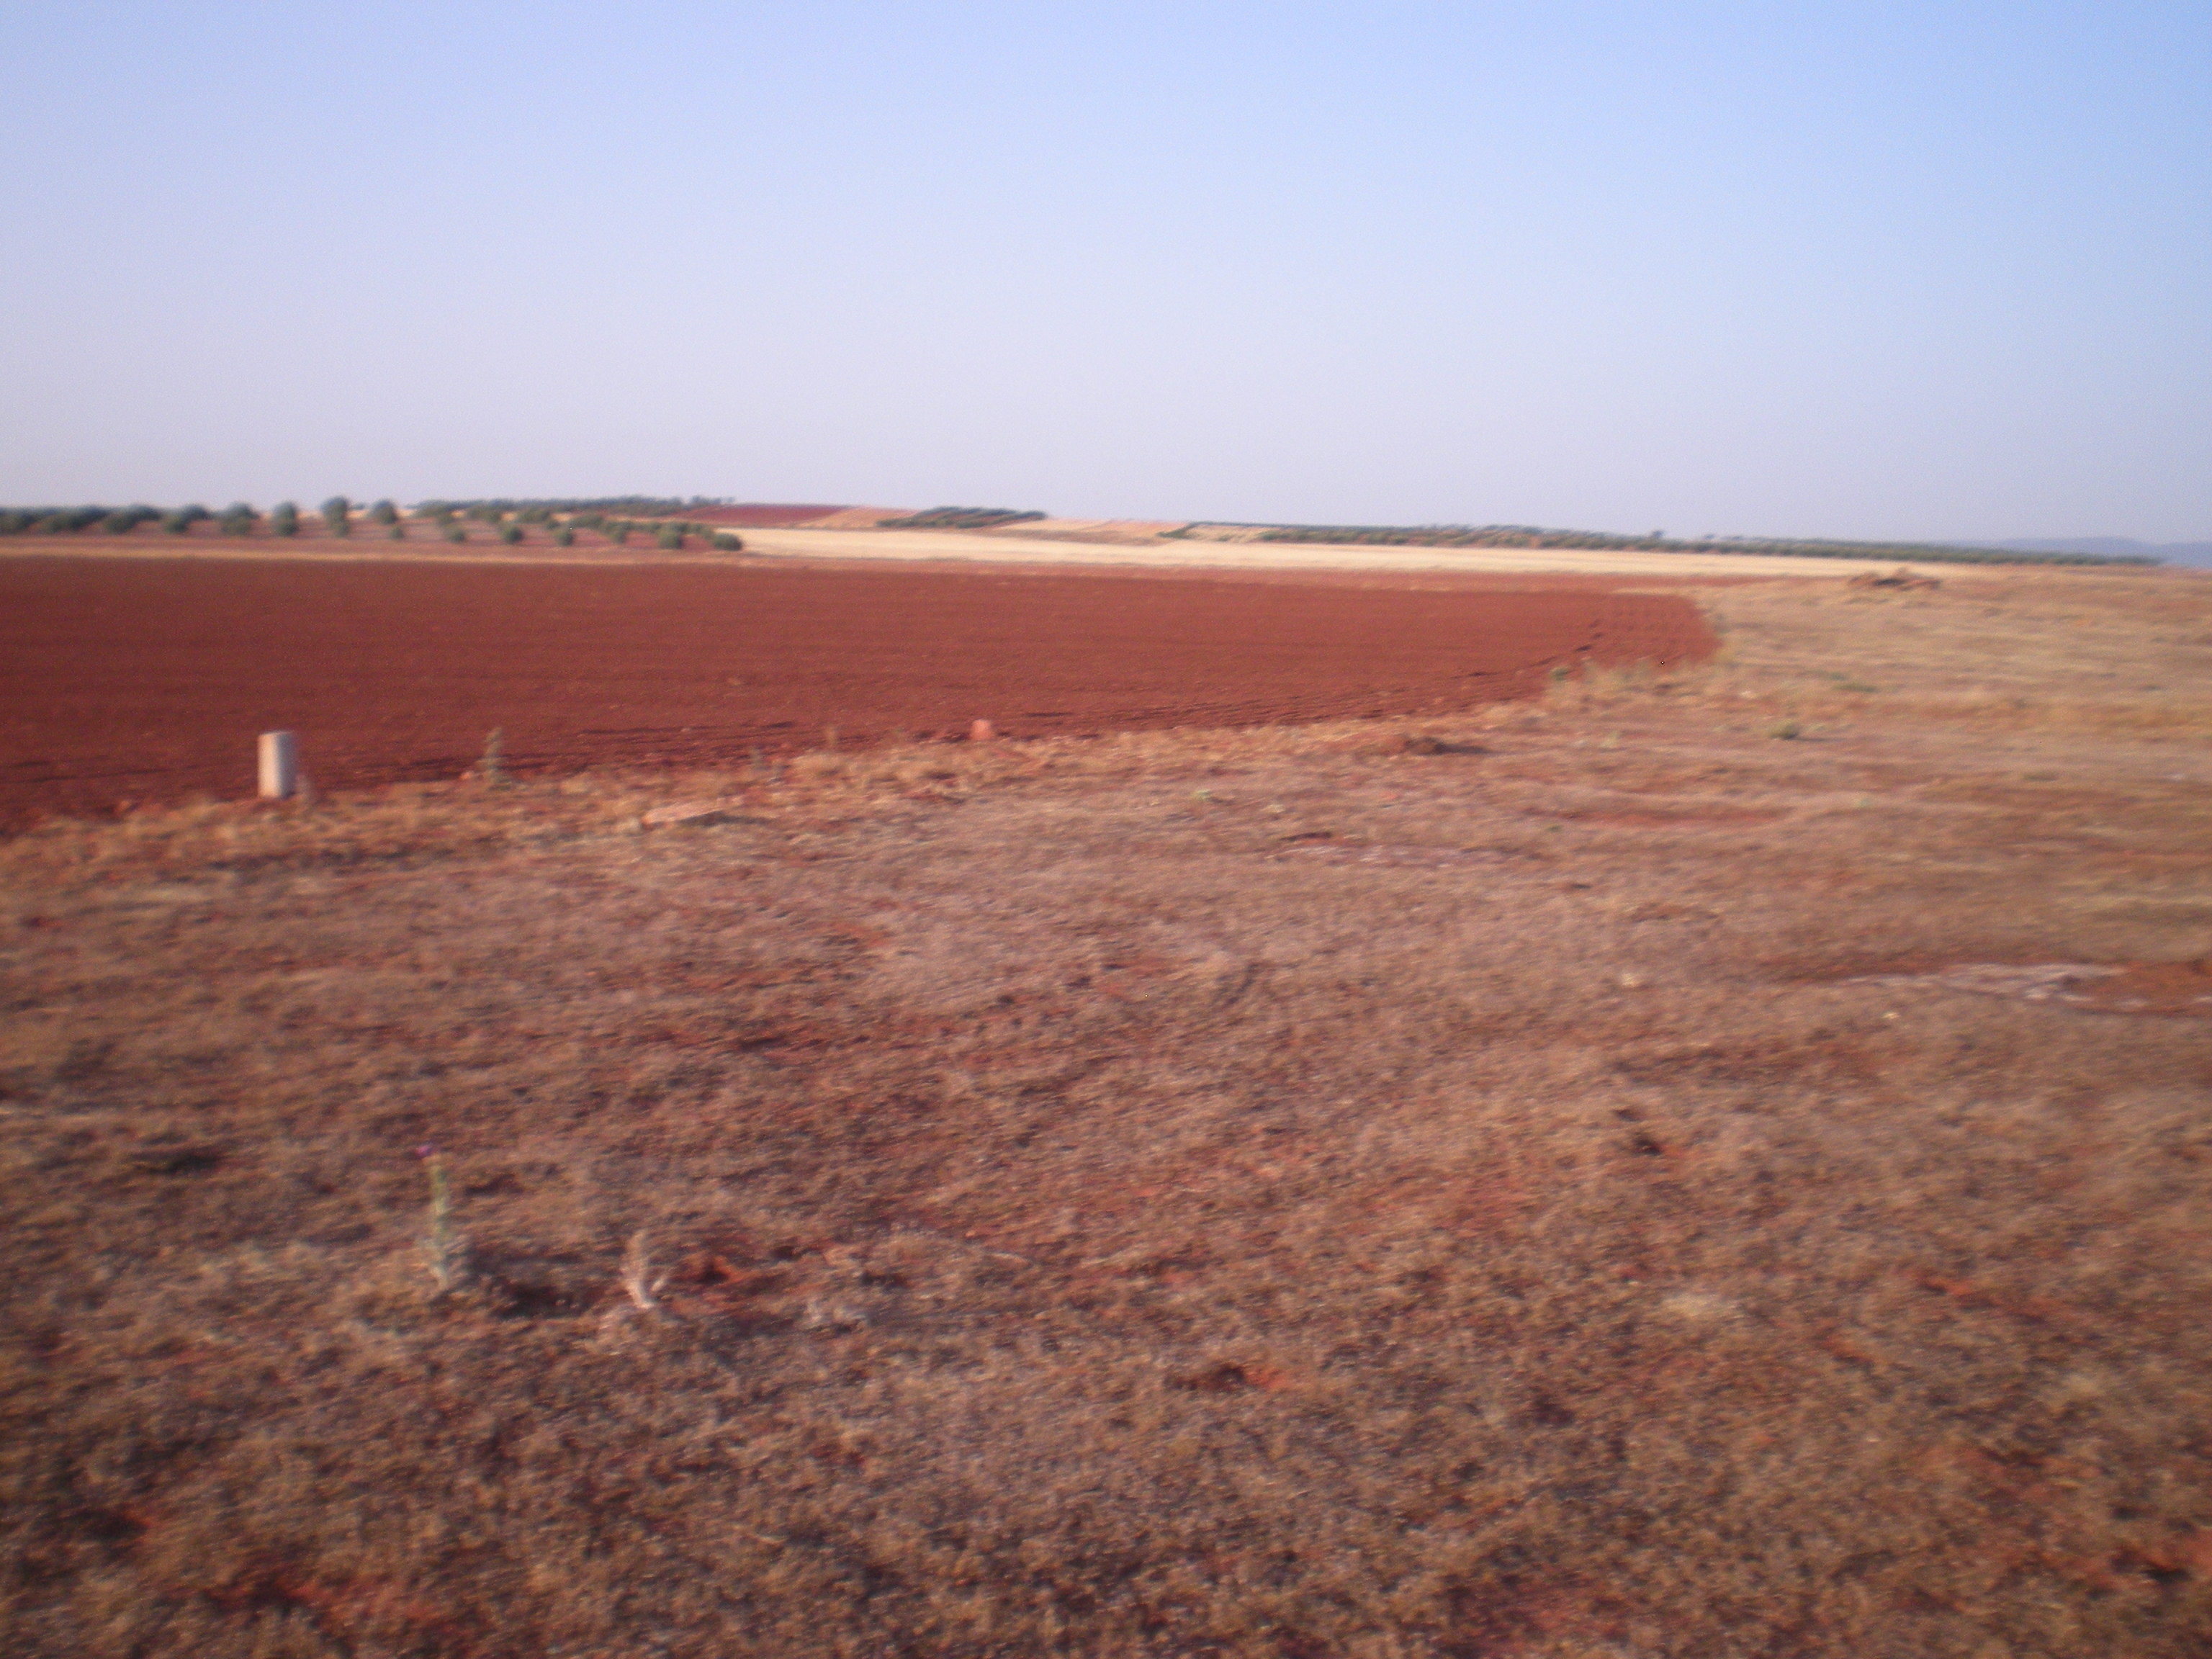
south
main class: Grassland
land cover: Grassland without tree/shrub cover
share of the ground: 25 - 50 %
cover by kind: unconsolidated bare surface 70 %, herbaceous plants 30 %
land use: Agriculture (excluding fallow land and kitchen gardens)
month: July
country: ES
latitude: 39.4487
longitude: -3.3018
